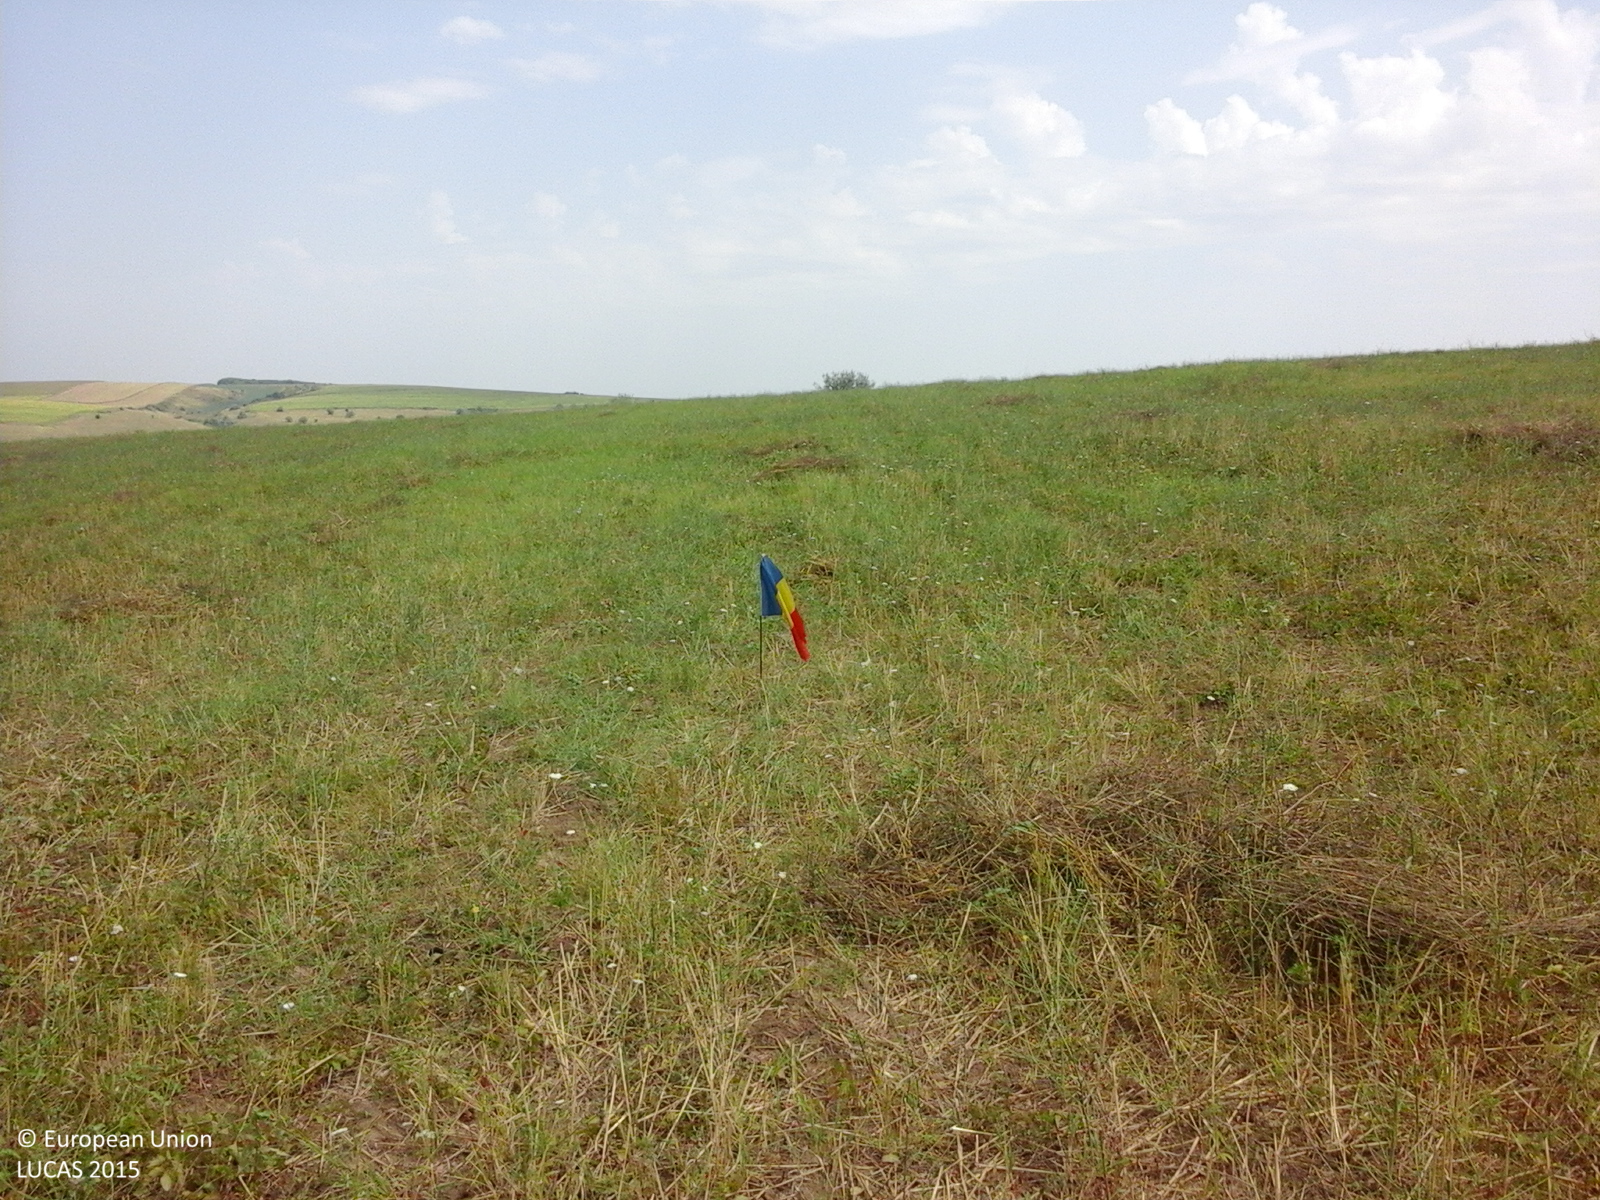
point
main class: Cropland
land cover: Common wheat
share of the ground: 10 - 25 %
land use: Agriculture (excluding fallow land and kitchen gardens)
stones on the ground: < 10 %
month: August
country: RO
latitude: 44.1623
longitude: 27.8953
